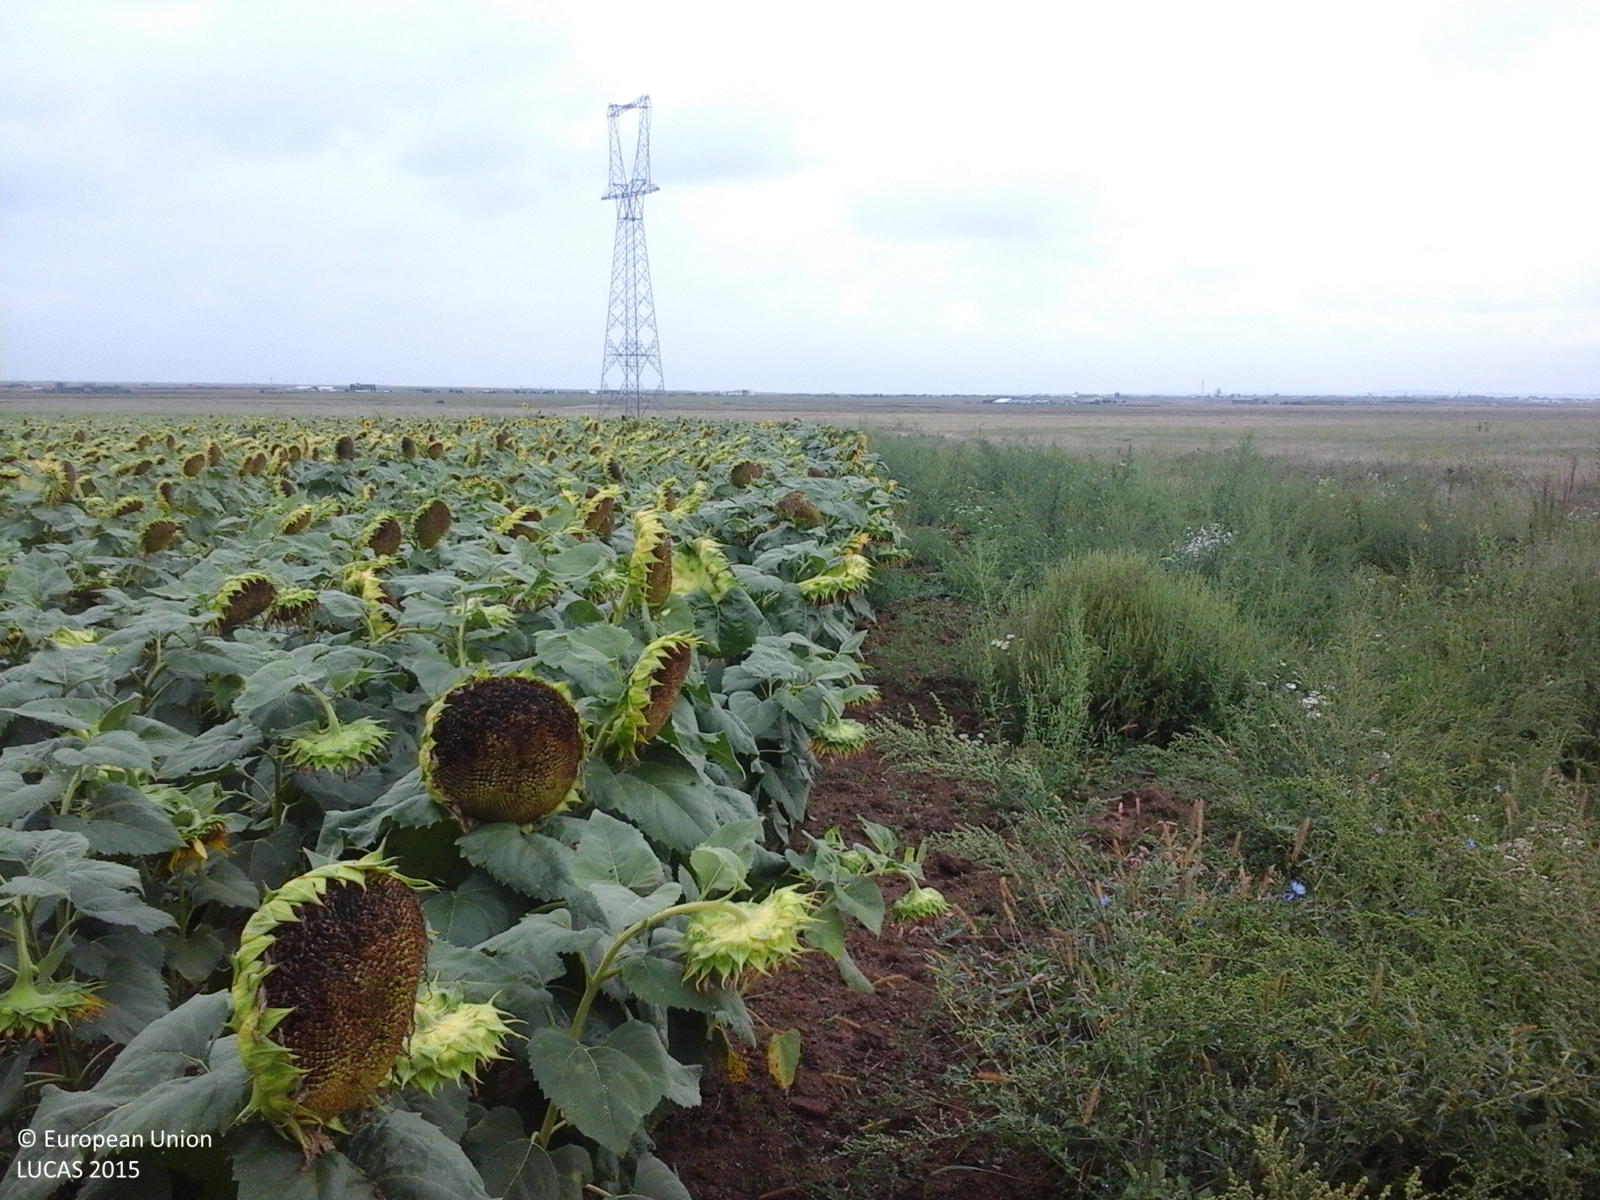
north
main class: Cropland
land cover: Sunflower
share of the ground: > 75 %
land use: Agriculture (excluding fallow land and kitchen gardens)
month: September
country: RO
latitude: 46.9624
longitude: 21.8595
